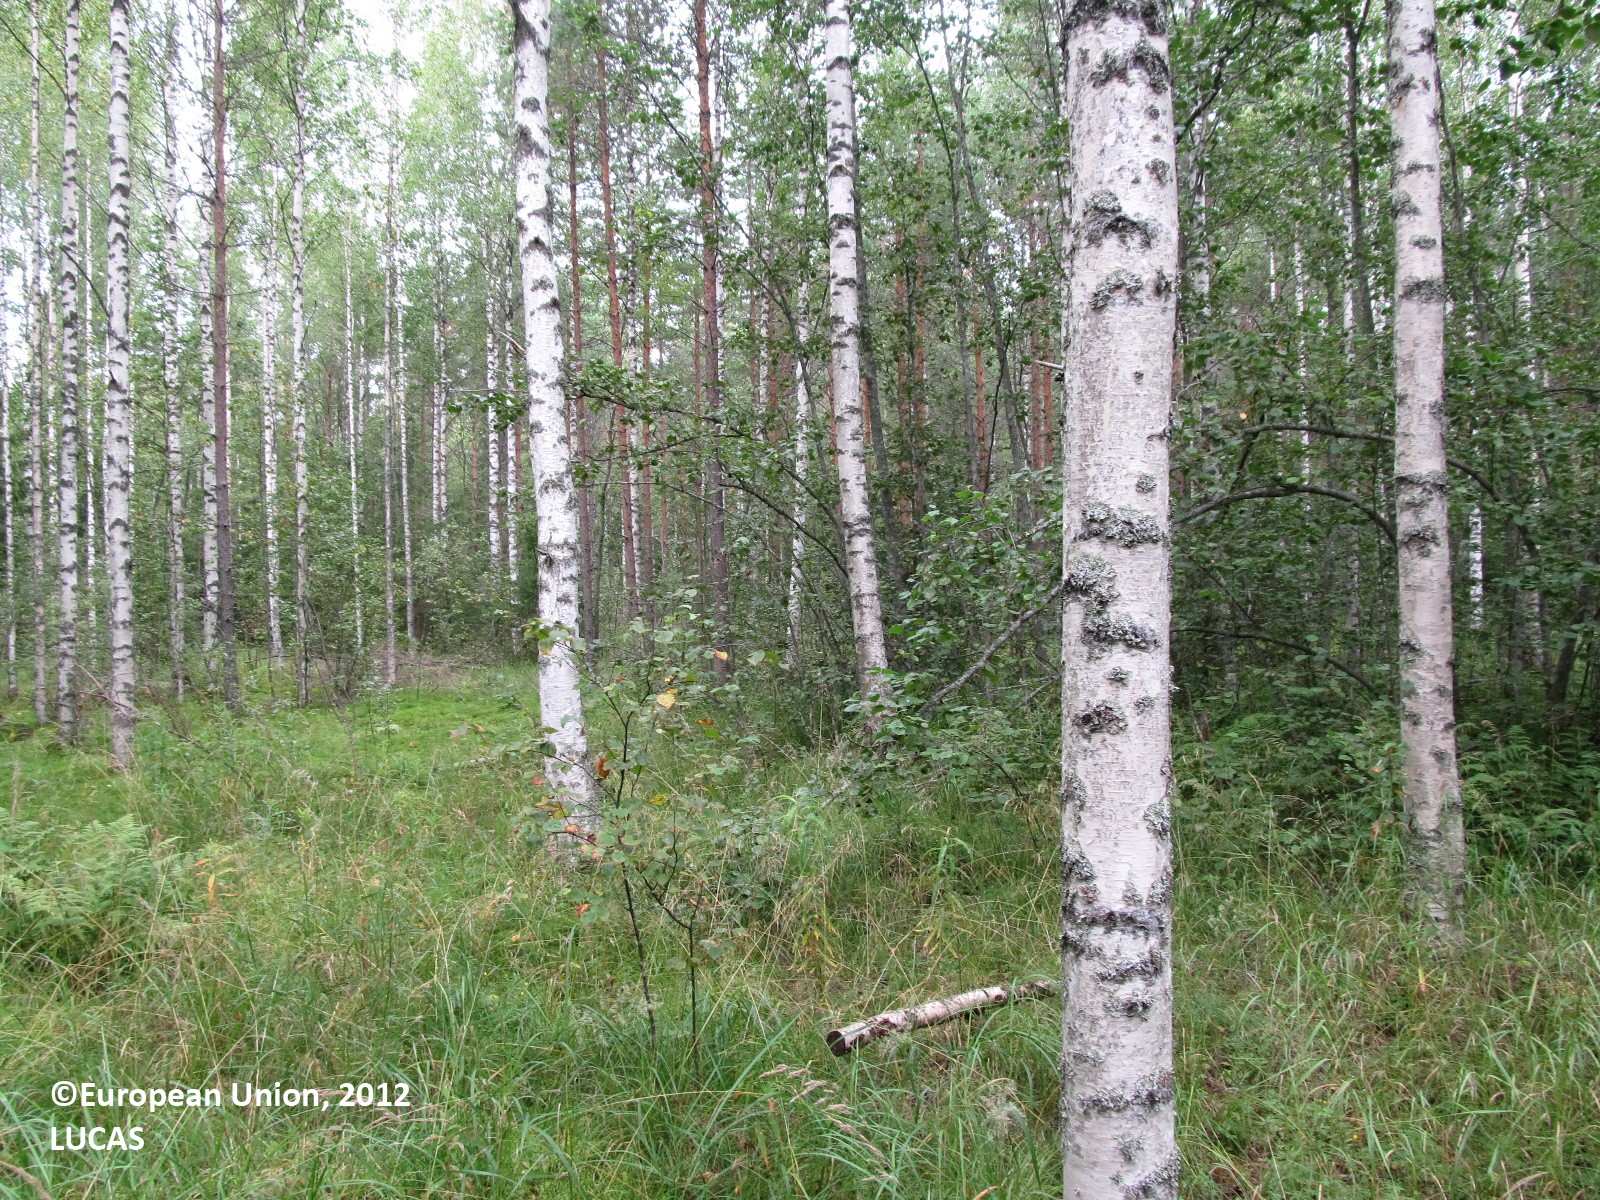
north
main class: Woodland
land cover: Spruce dominated mixed woodland
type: boreal forest
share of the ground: 25 - 50 %
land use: Forestry
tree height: > 5 m
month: August
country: FI
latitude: 62.0109
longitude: 27.4177
